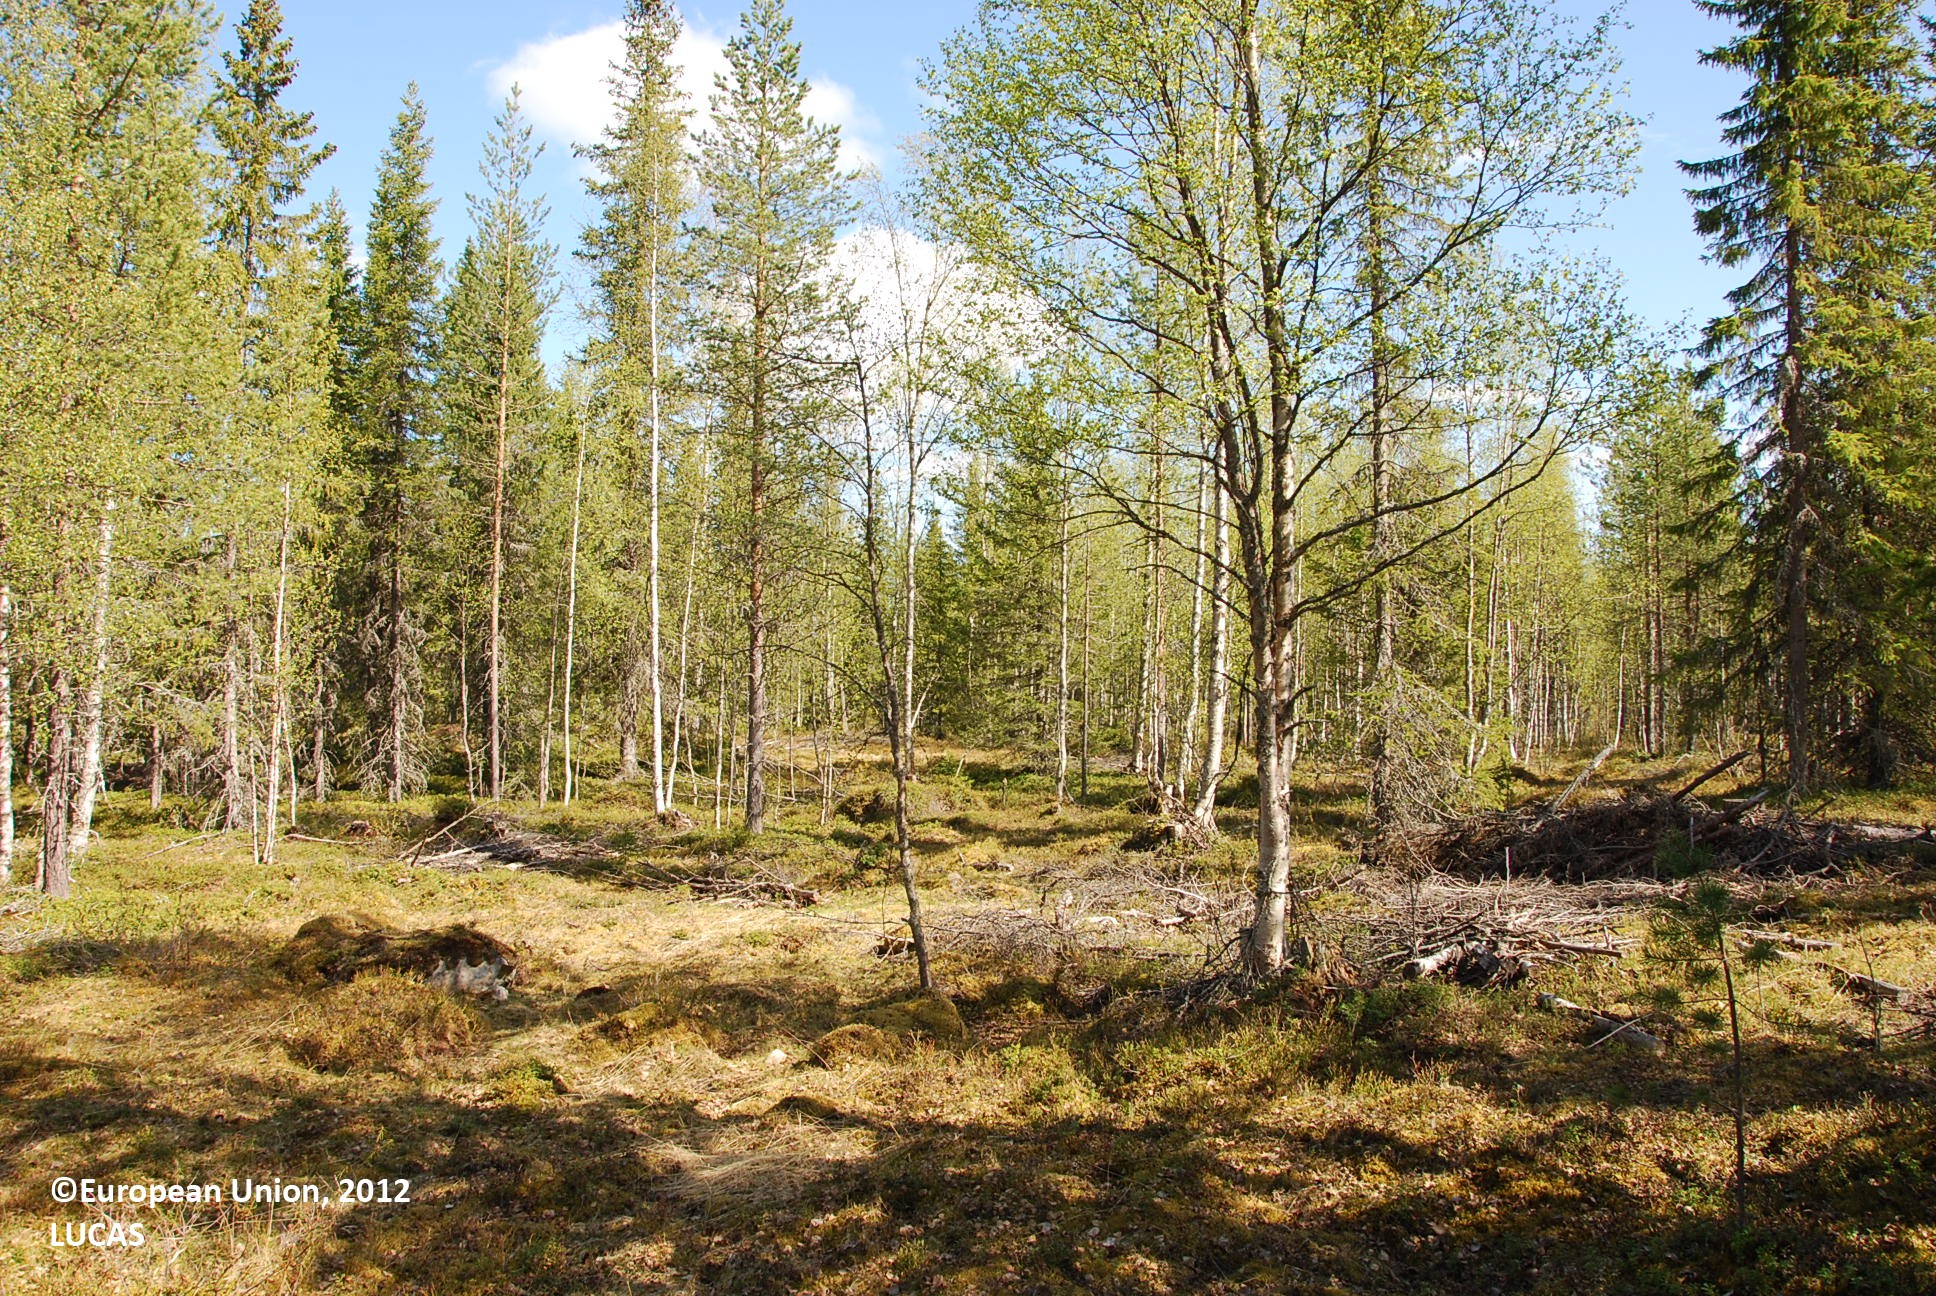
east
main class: Woodland
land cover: Spruce dominated mixed woodland
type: boreal forest
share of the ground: 50 - 75 %
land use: Forestry
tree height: > 5 m
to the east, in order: Spruce dominated mixed woodland; Pine dominated mixed woodland; Tracks; Broadleaved woodland; Spruce dominated mixed woodland; Tracks; Spruce dominated mixed woodland
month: June
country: FI
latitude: 66.9655
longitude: 28.2925
